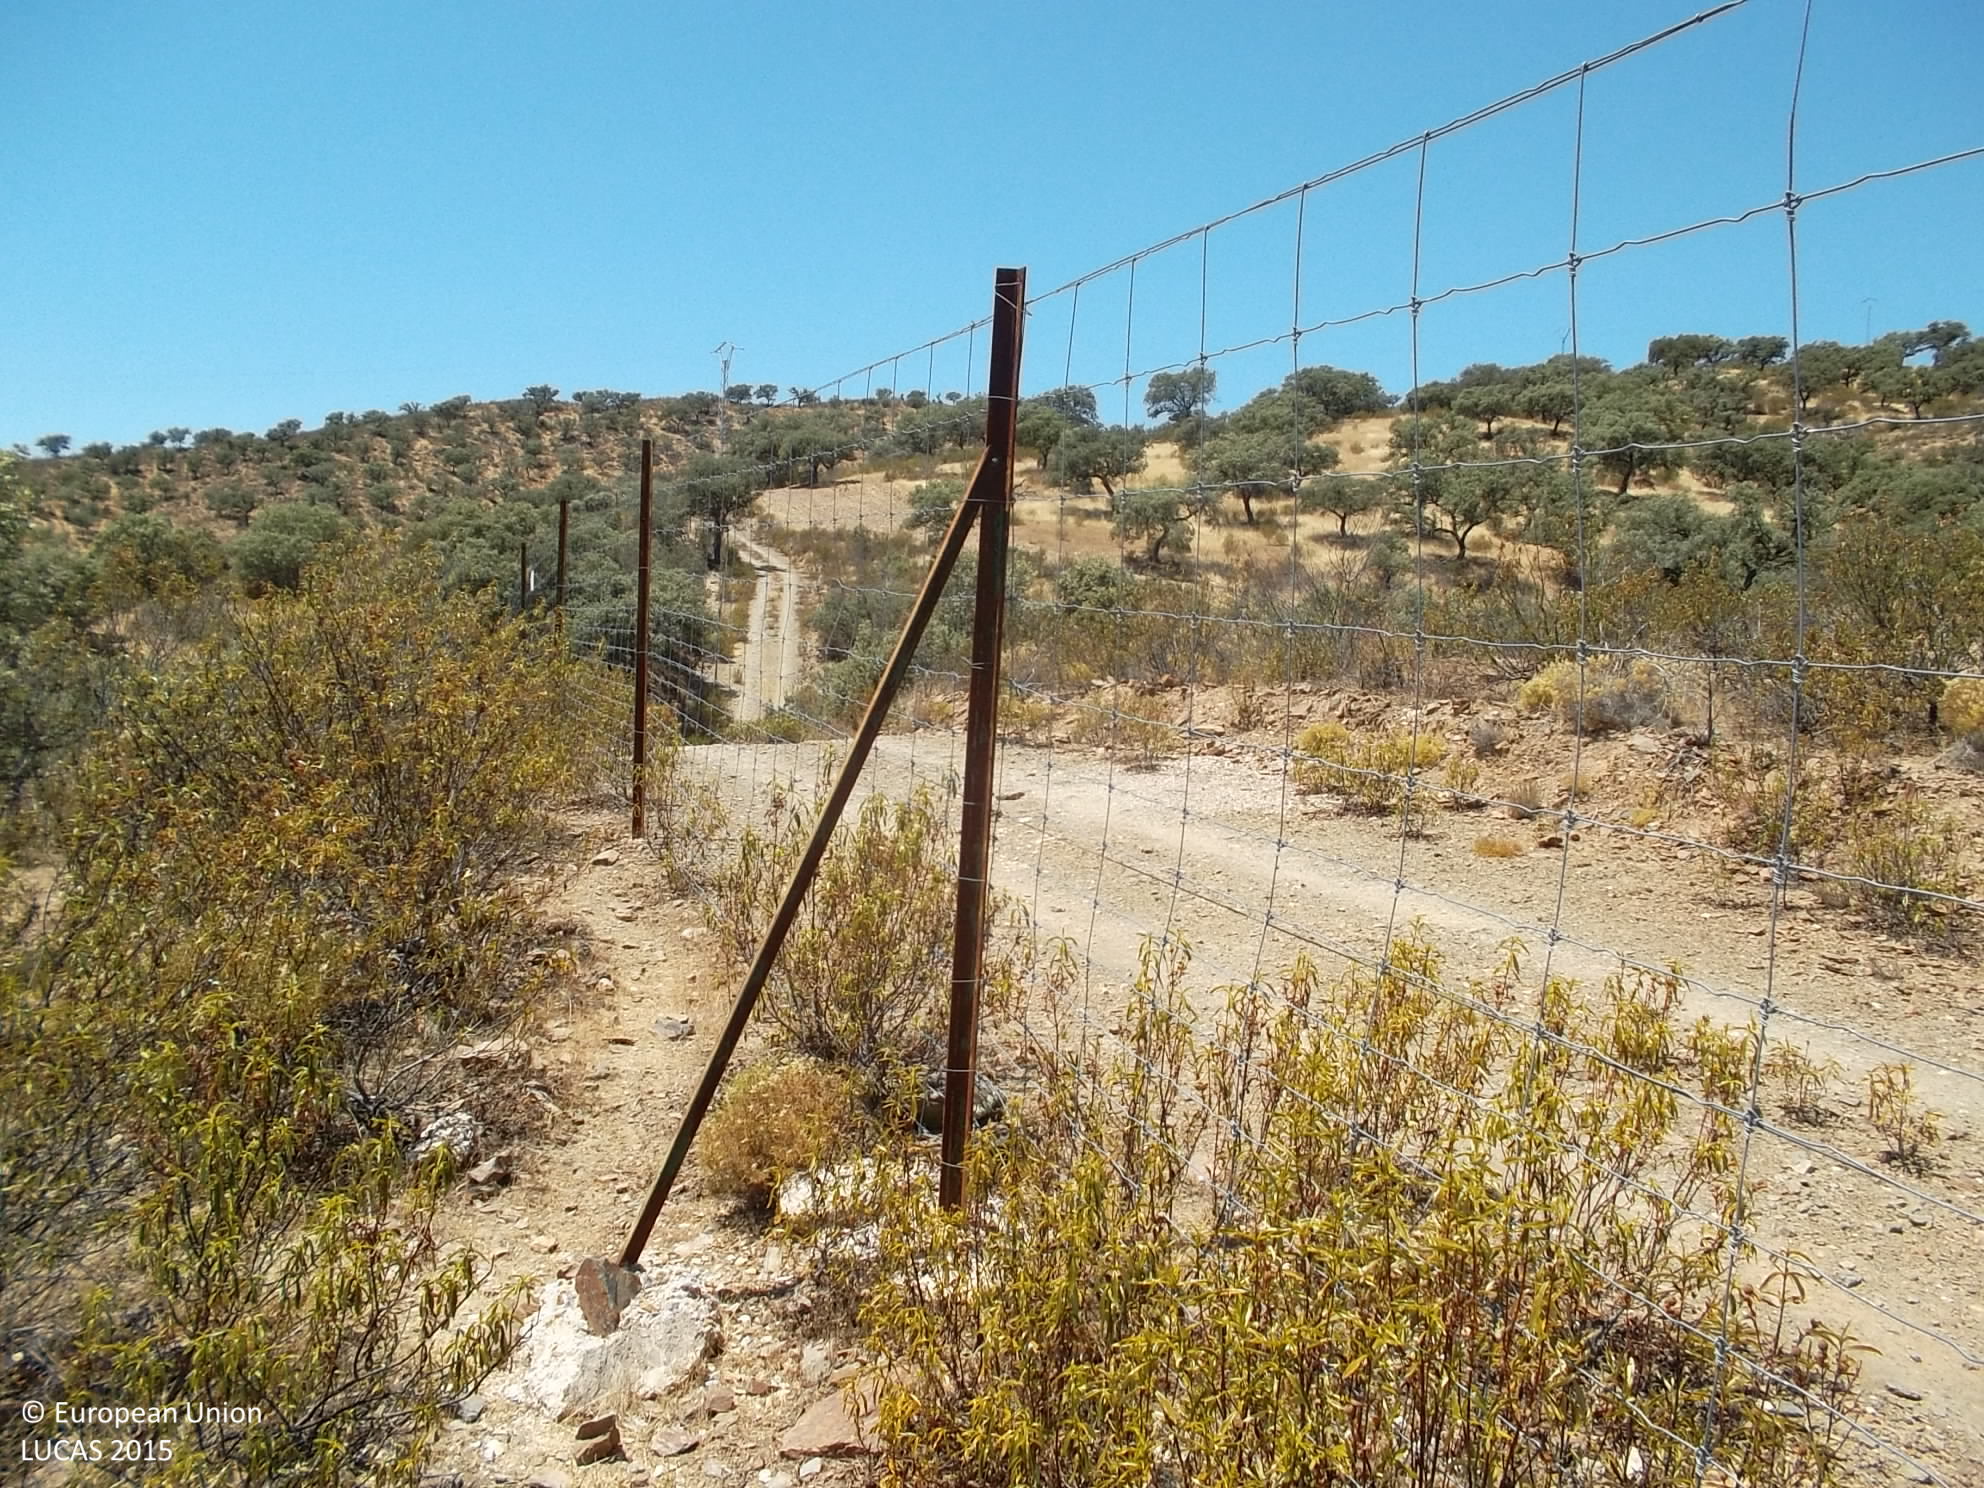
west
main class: Woodland
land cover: Broadleaved woodland
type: broadleaved evergreen forest
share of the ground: 25 - 50 %
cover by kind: shrubs 70 %, broadleaved forest trees 30 %
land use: Forestry
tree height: > 5 m
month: July
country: ES
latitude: 38.1871
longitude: -5.6859
